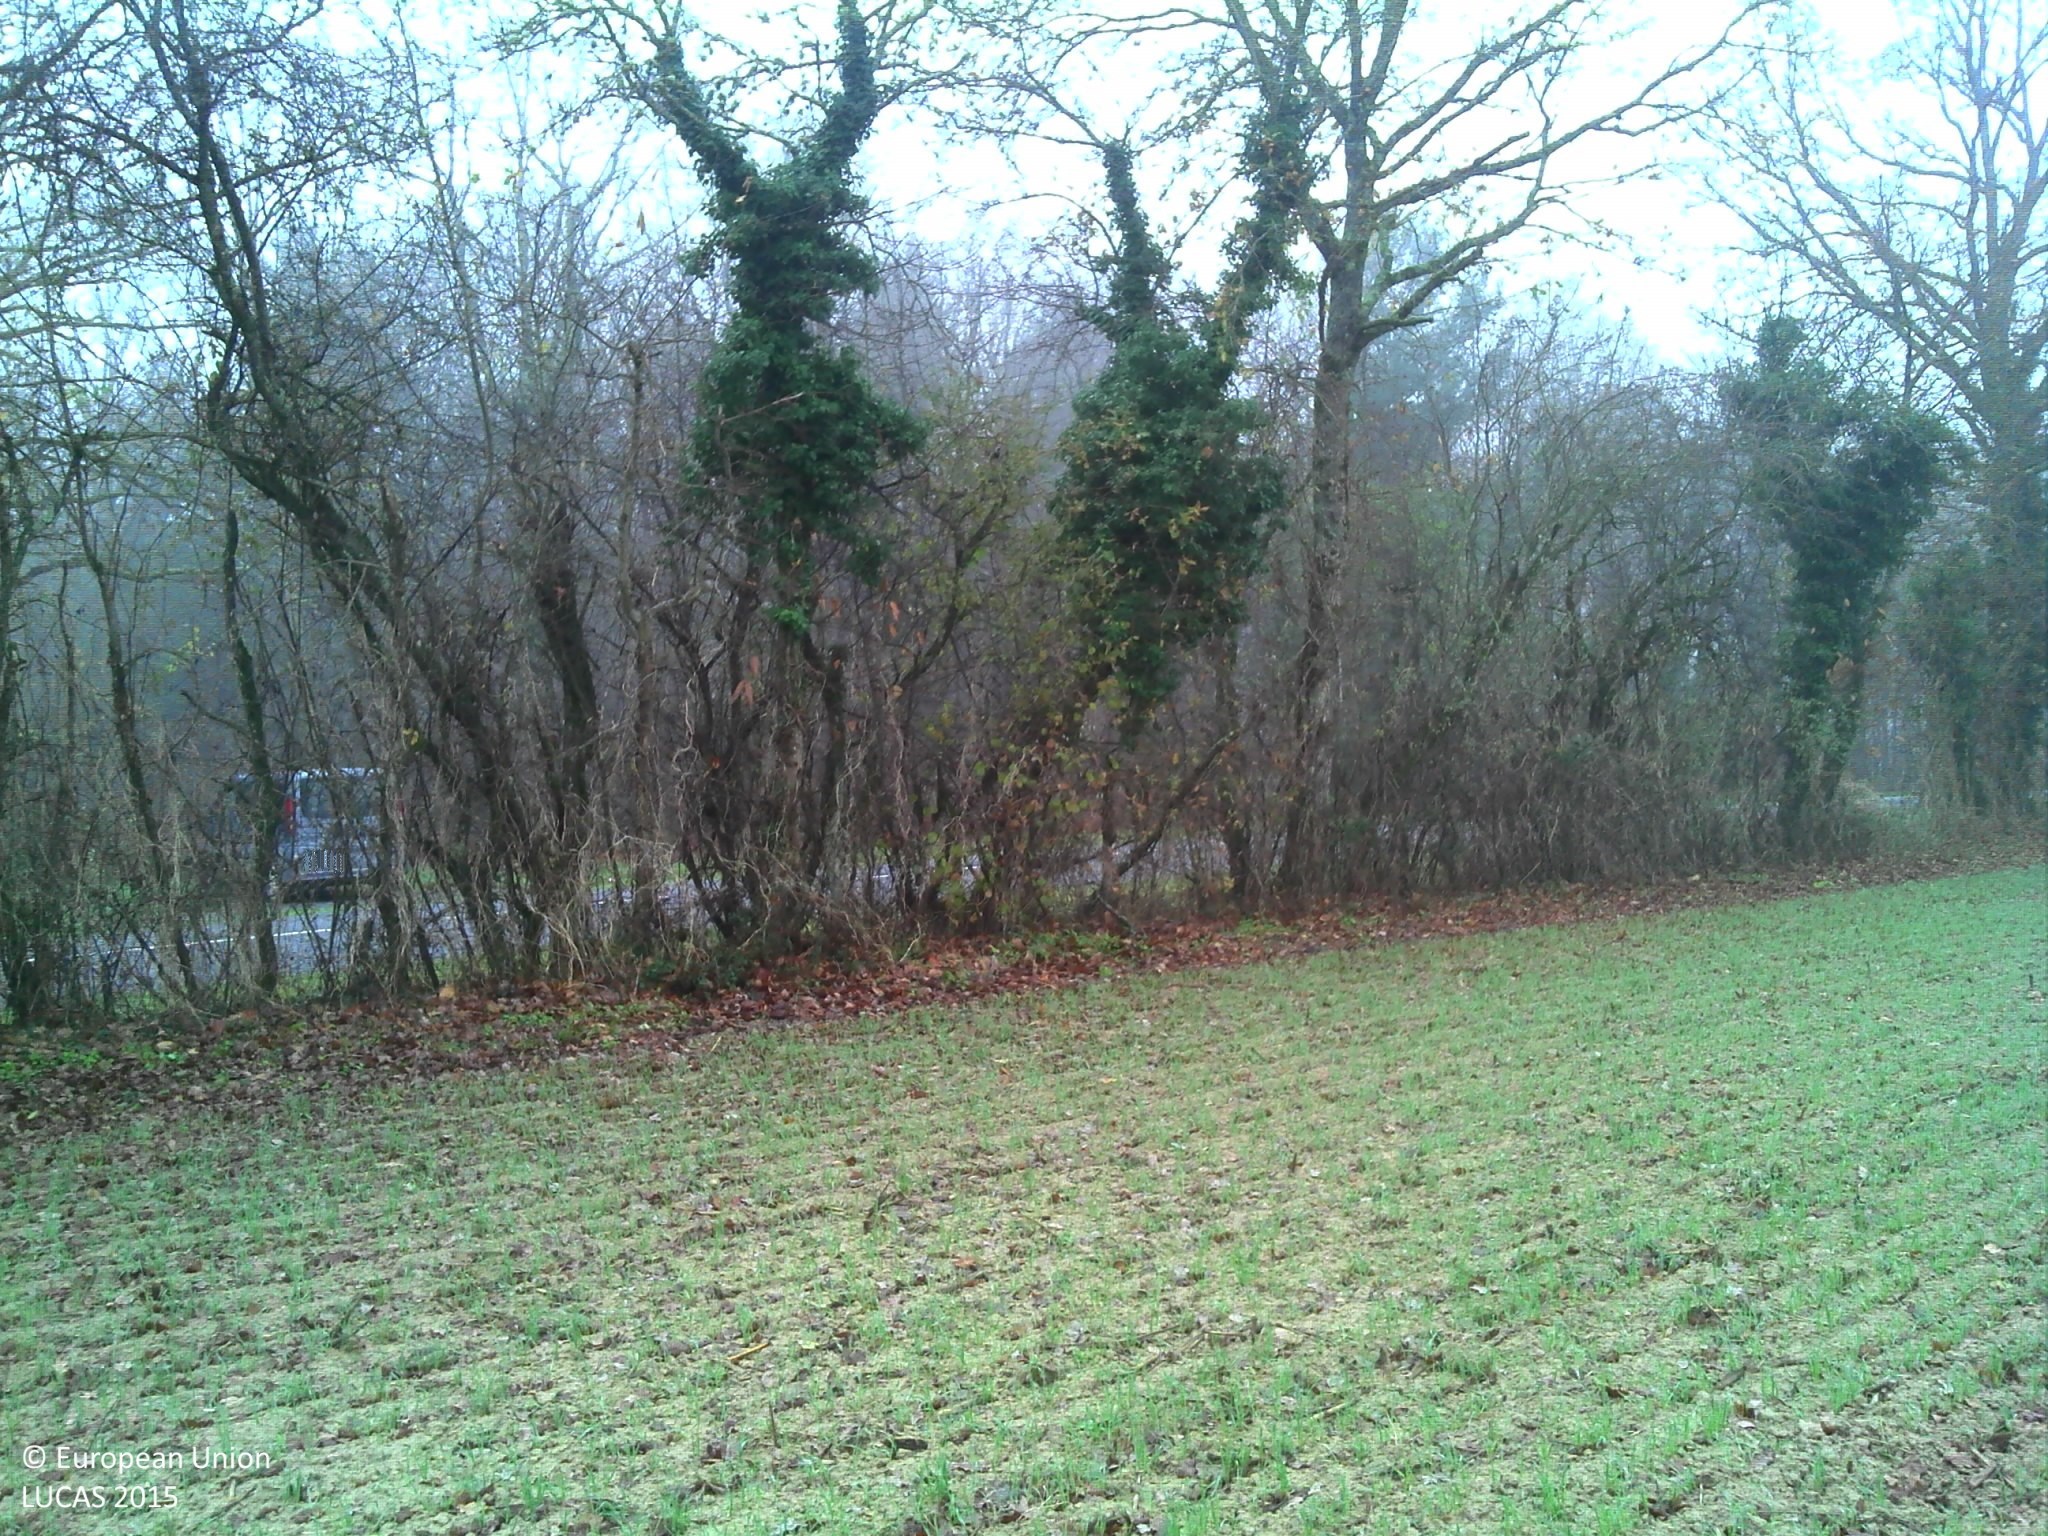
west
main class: Cropland
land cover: Common wheat
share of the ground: 50 - 75 %
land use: Agriculture (excluding fallow land and kitchen gardens)
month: November
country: FR
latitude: 46.5418
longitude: 3.6486
